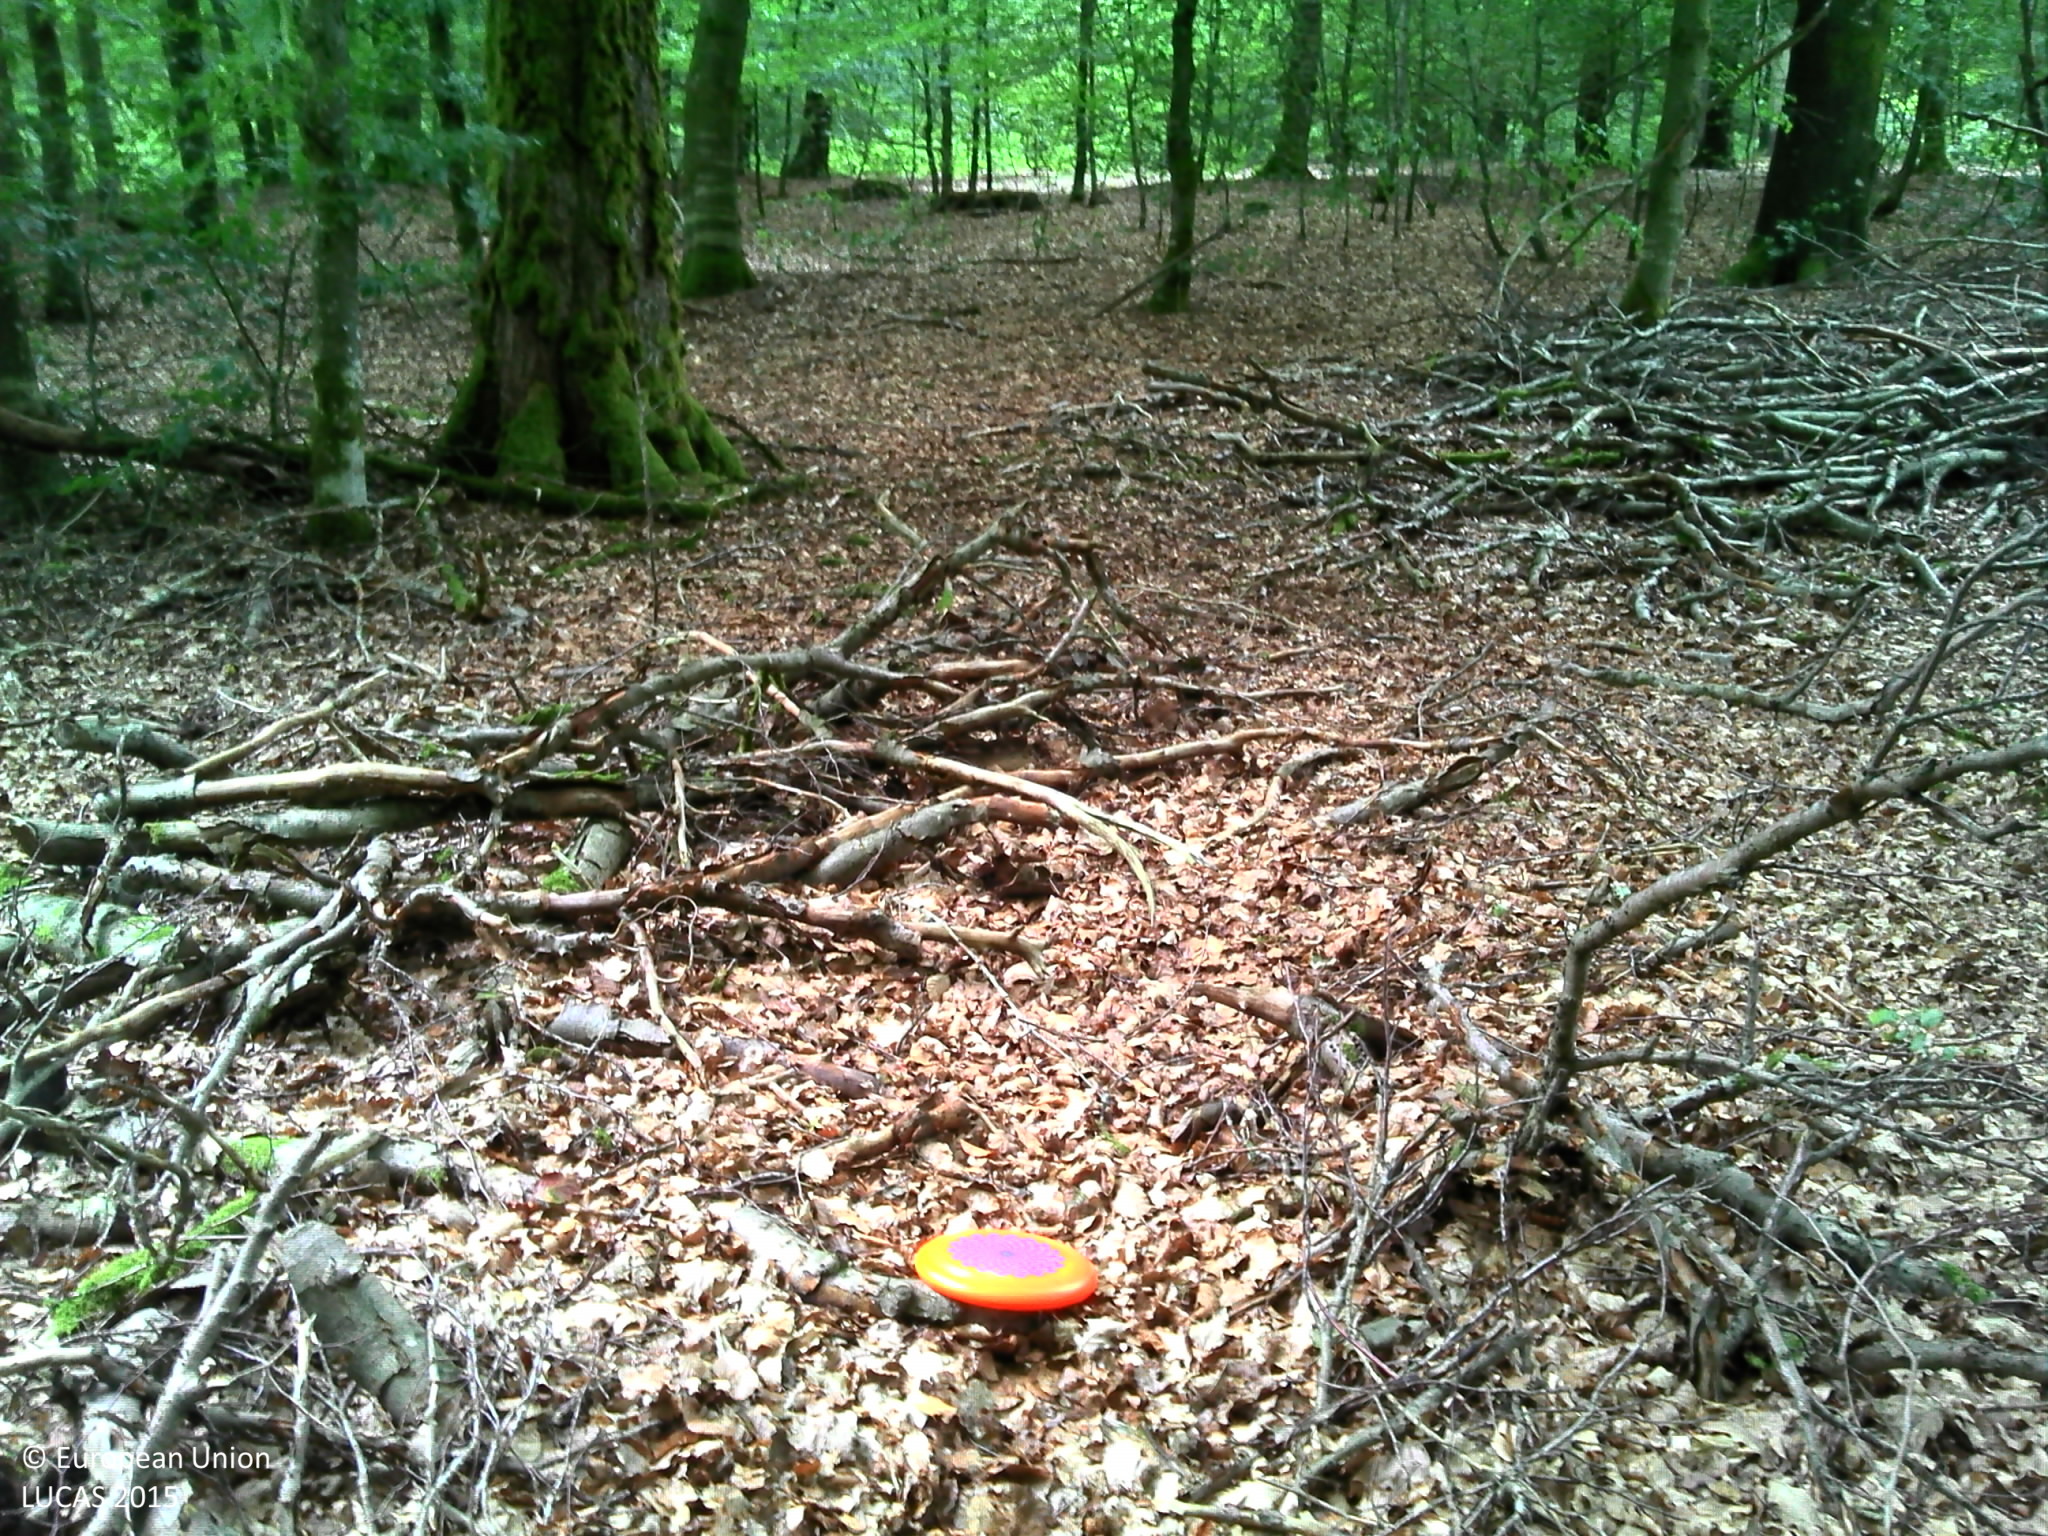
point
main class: Woodland
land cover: Broadleaved woodland
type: beech forest
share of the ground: > 75 %
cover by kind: broadleaved forest trees 90 %, unconsolidated bare surface 10 %
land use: Forestry
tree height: > 5 m
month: July
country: BE
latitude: 49.7783
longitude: 5.6798
